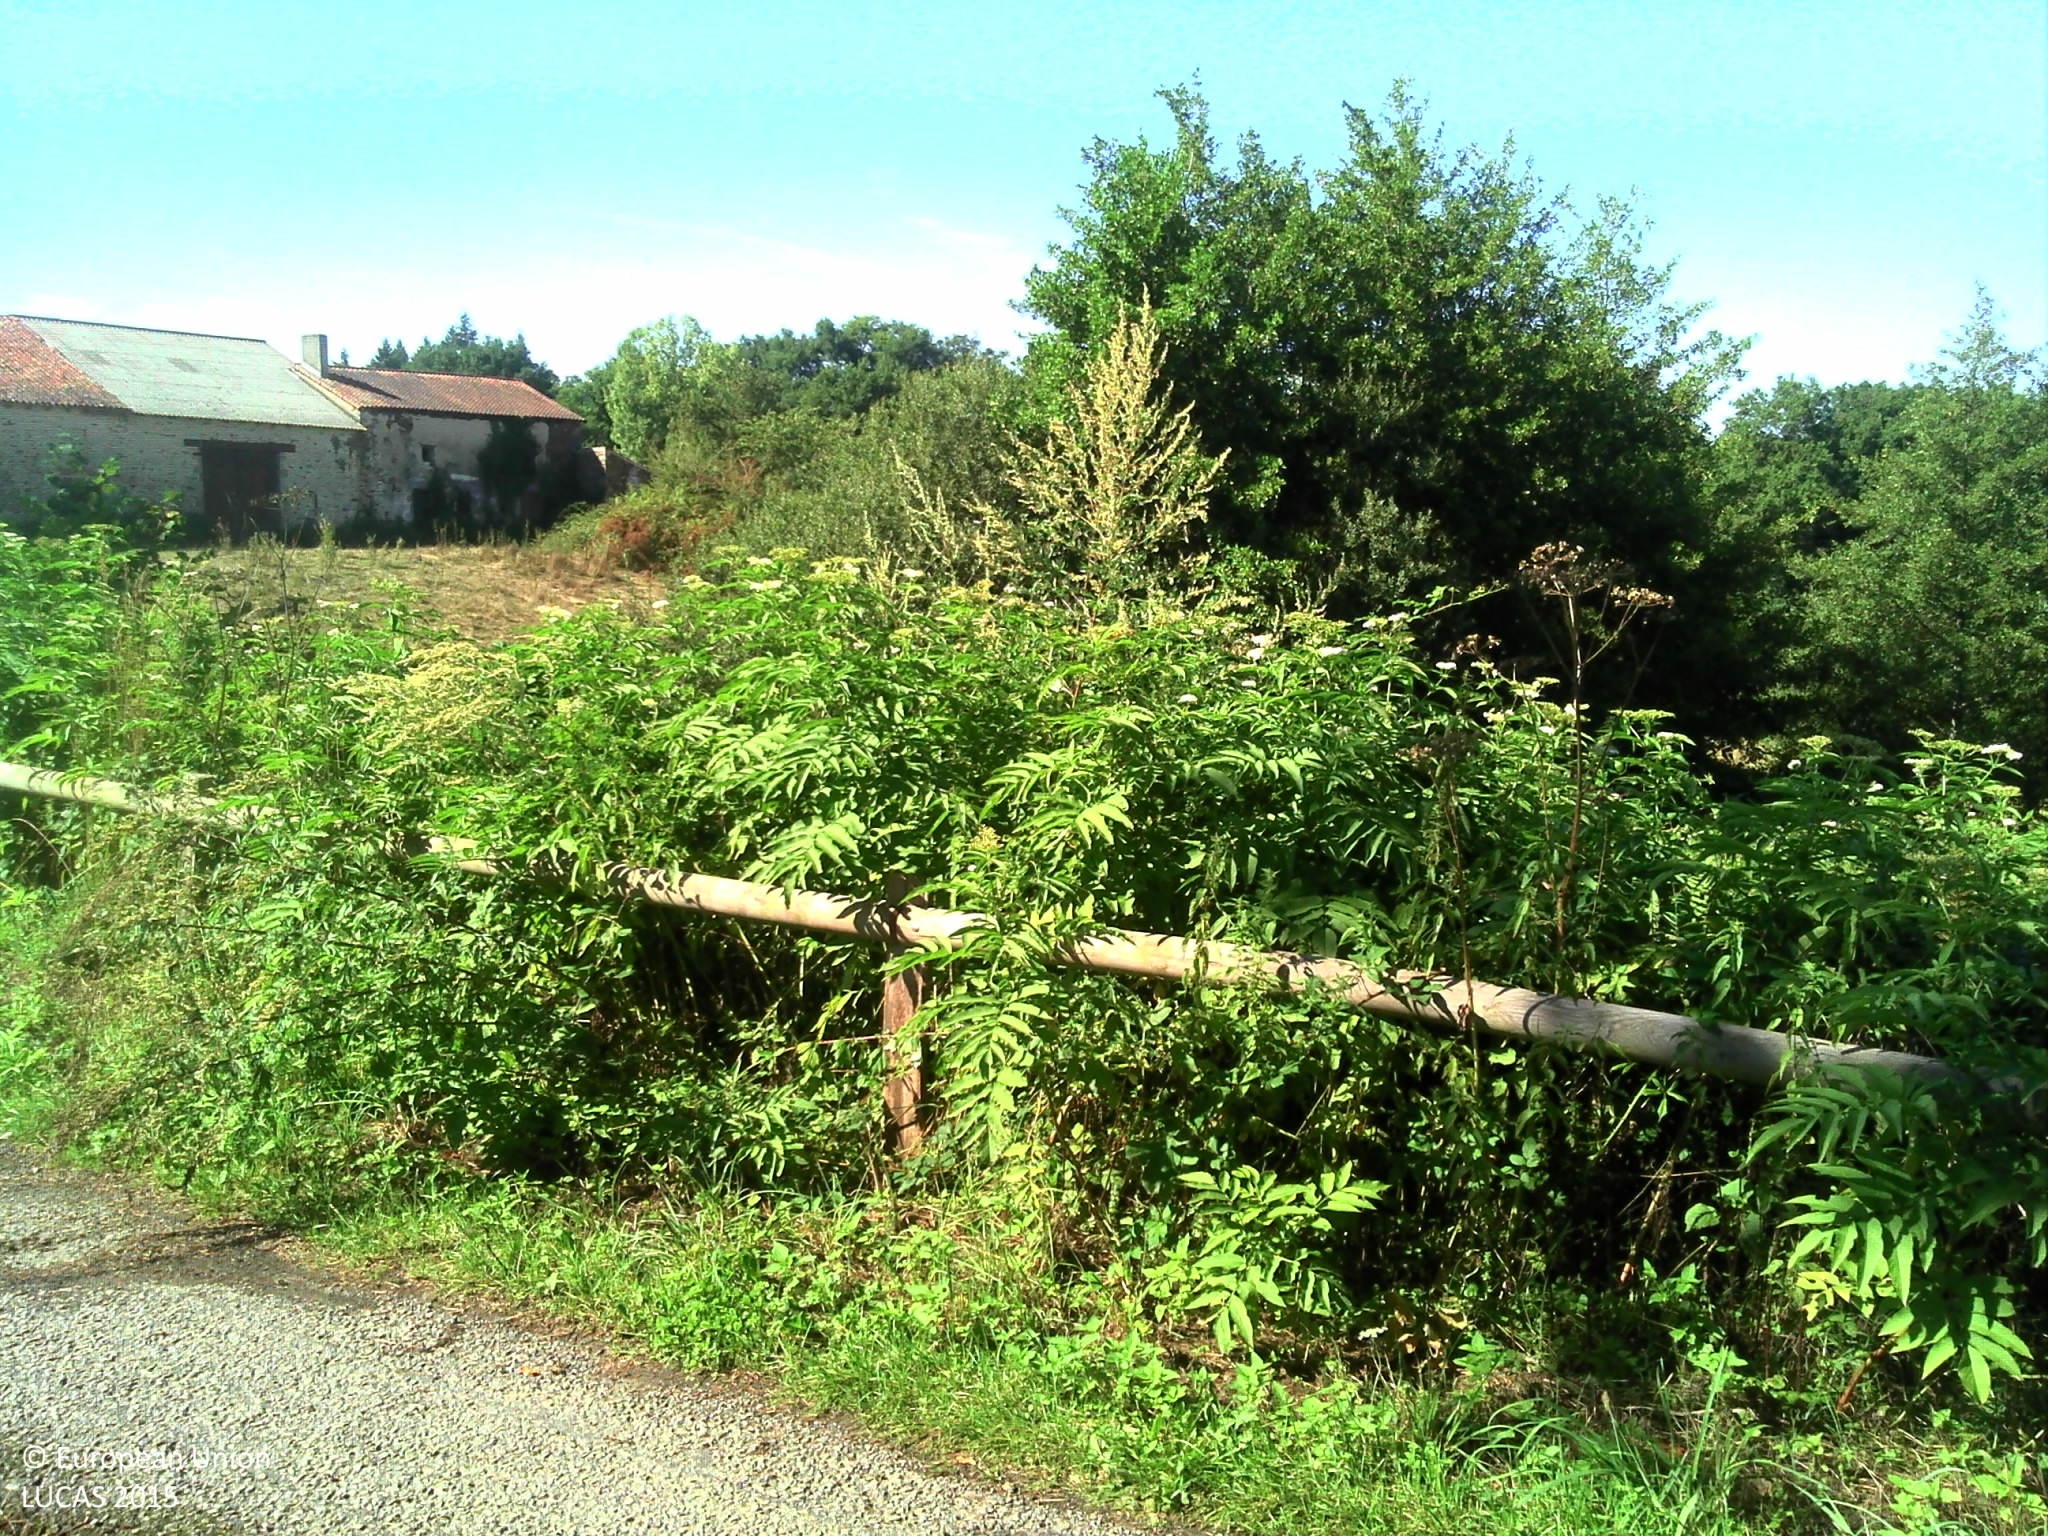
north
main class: Grassland
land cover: Grassland without tree/shrub cover
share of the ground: > 75 %
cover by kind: herbaceous plants 100 %
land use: Agriculture (excluding fallow land and kitchen gardens)
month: August
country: FR
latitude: 46.1470
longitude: 0.9376
